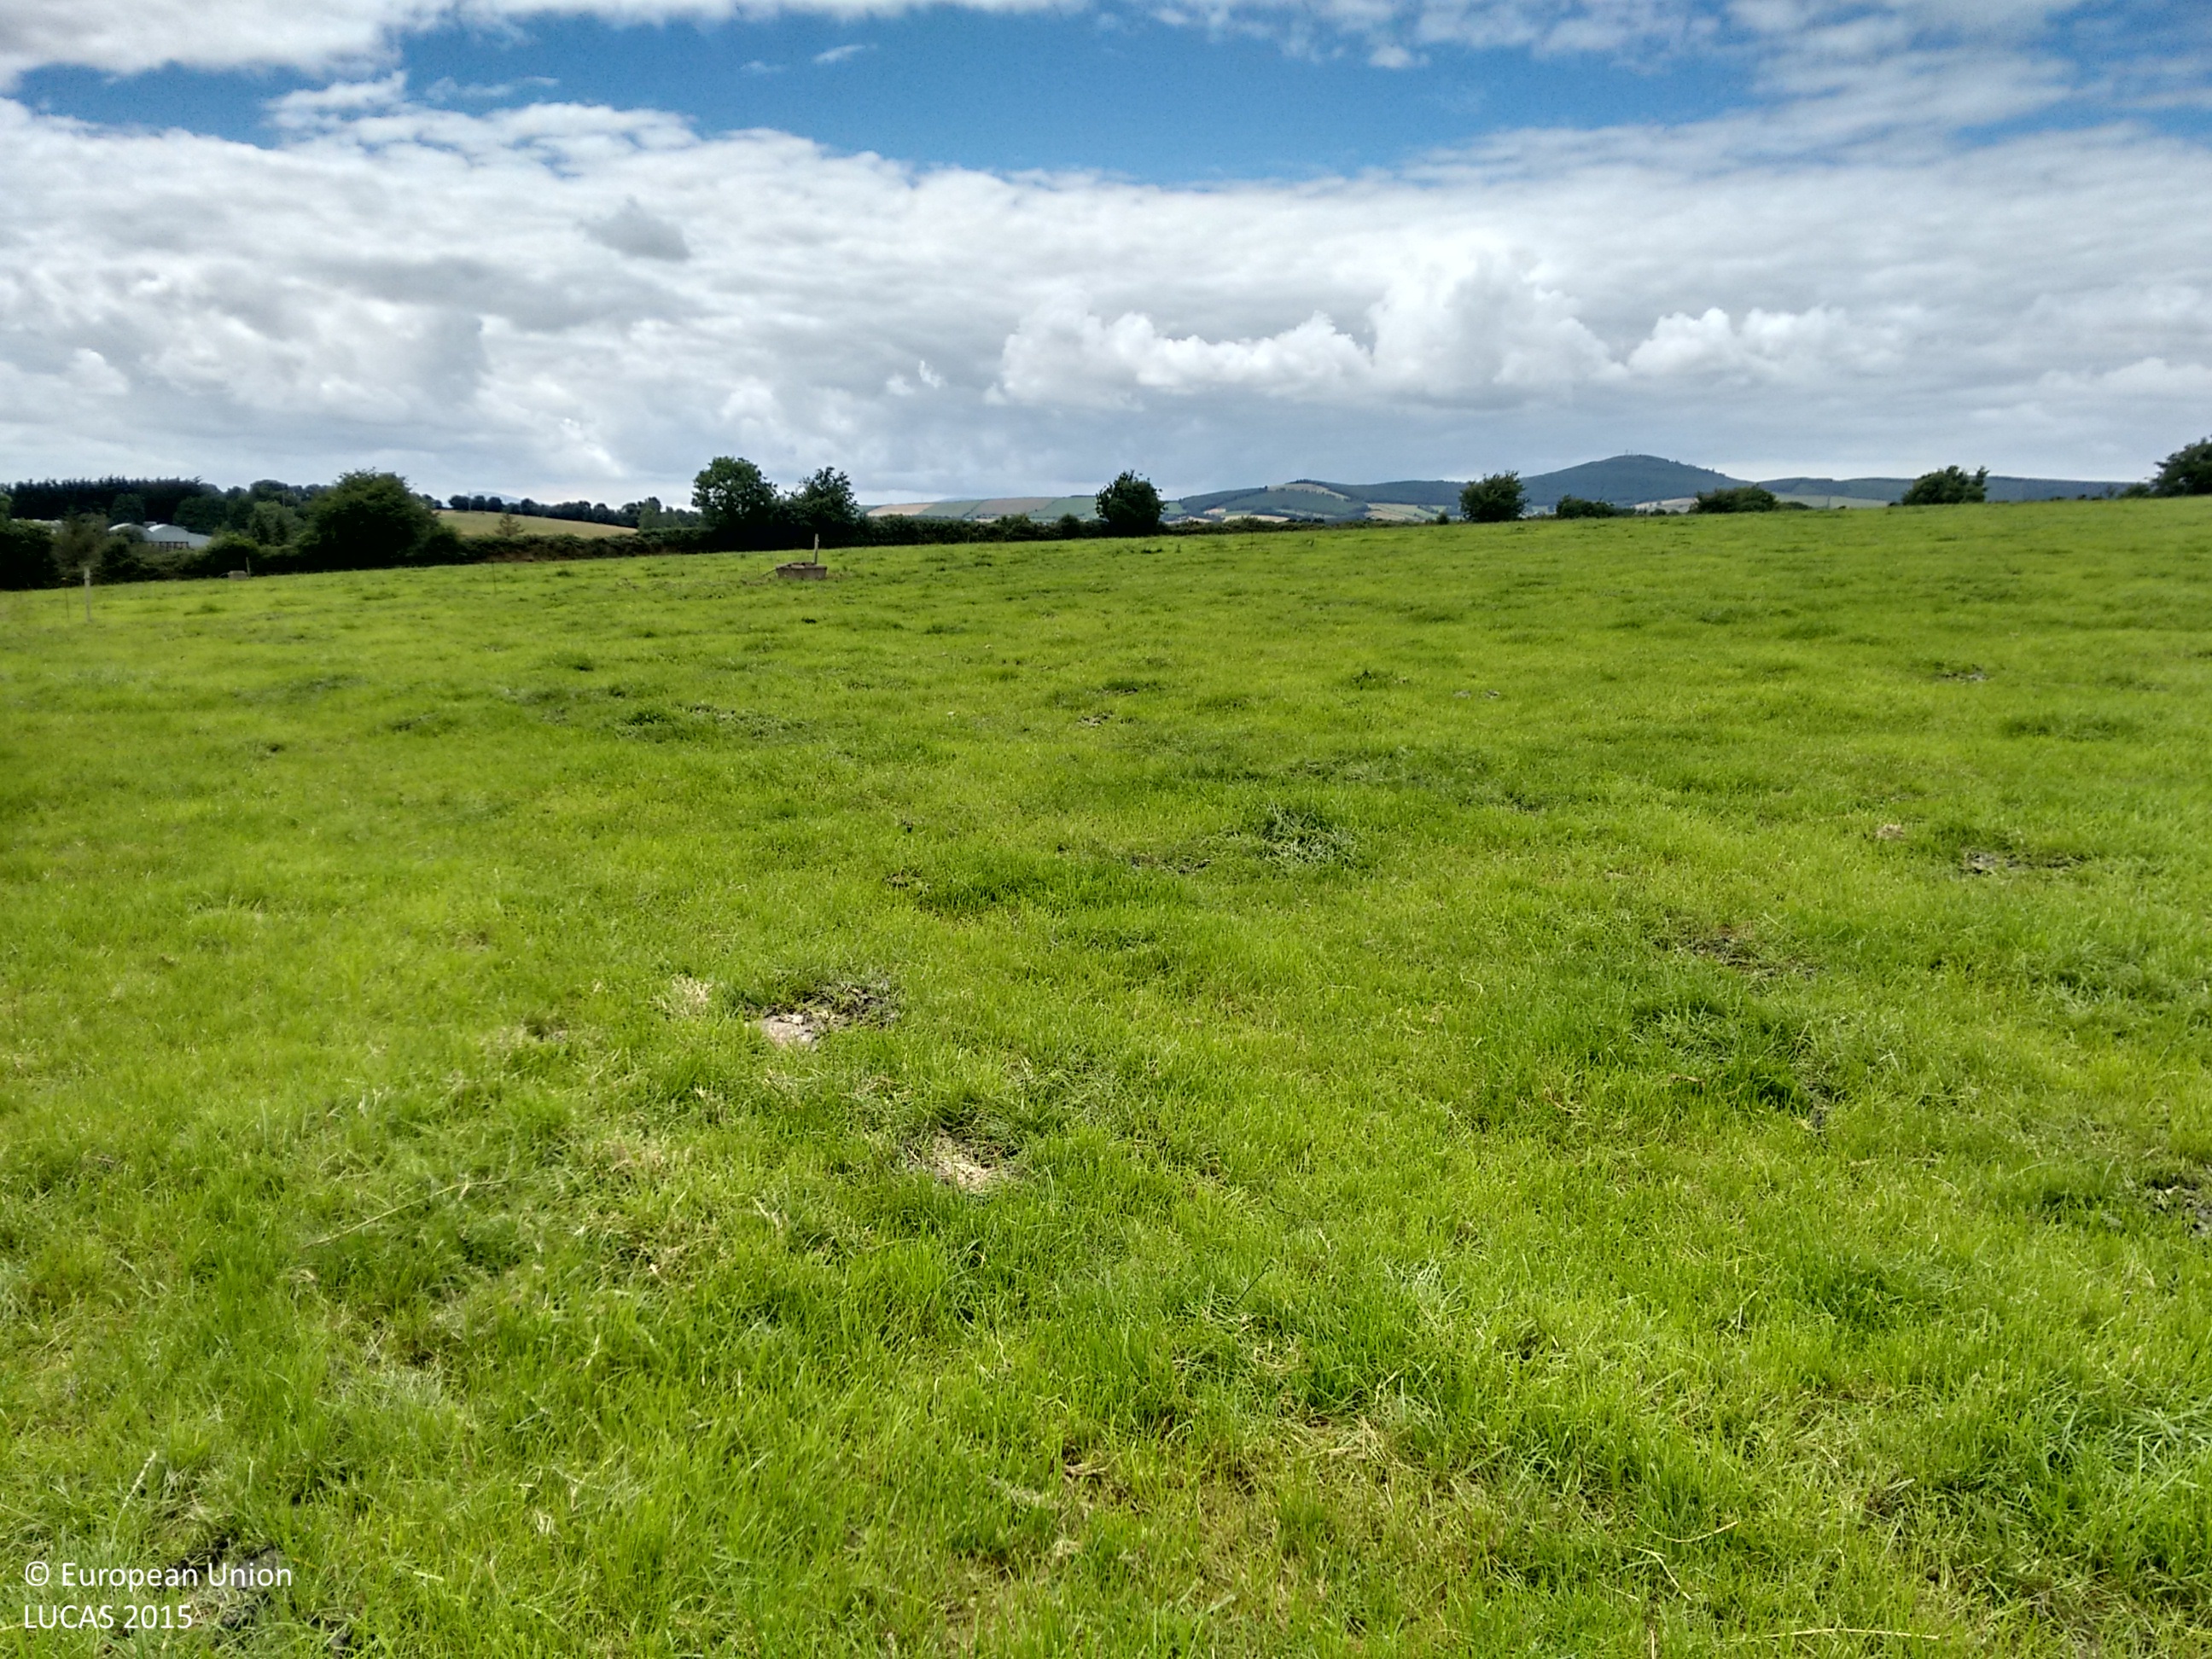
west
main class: Grassland
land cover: Grassland without tree/shrub cover
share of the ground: > 75 %
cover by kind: herbaceous plants 95 %, unconsolidated bare surface 5 %
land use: Agriculture (excluding fallow land and kitchen gardens)
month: August
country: IE
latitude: 52.6406
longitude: -6.3952
